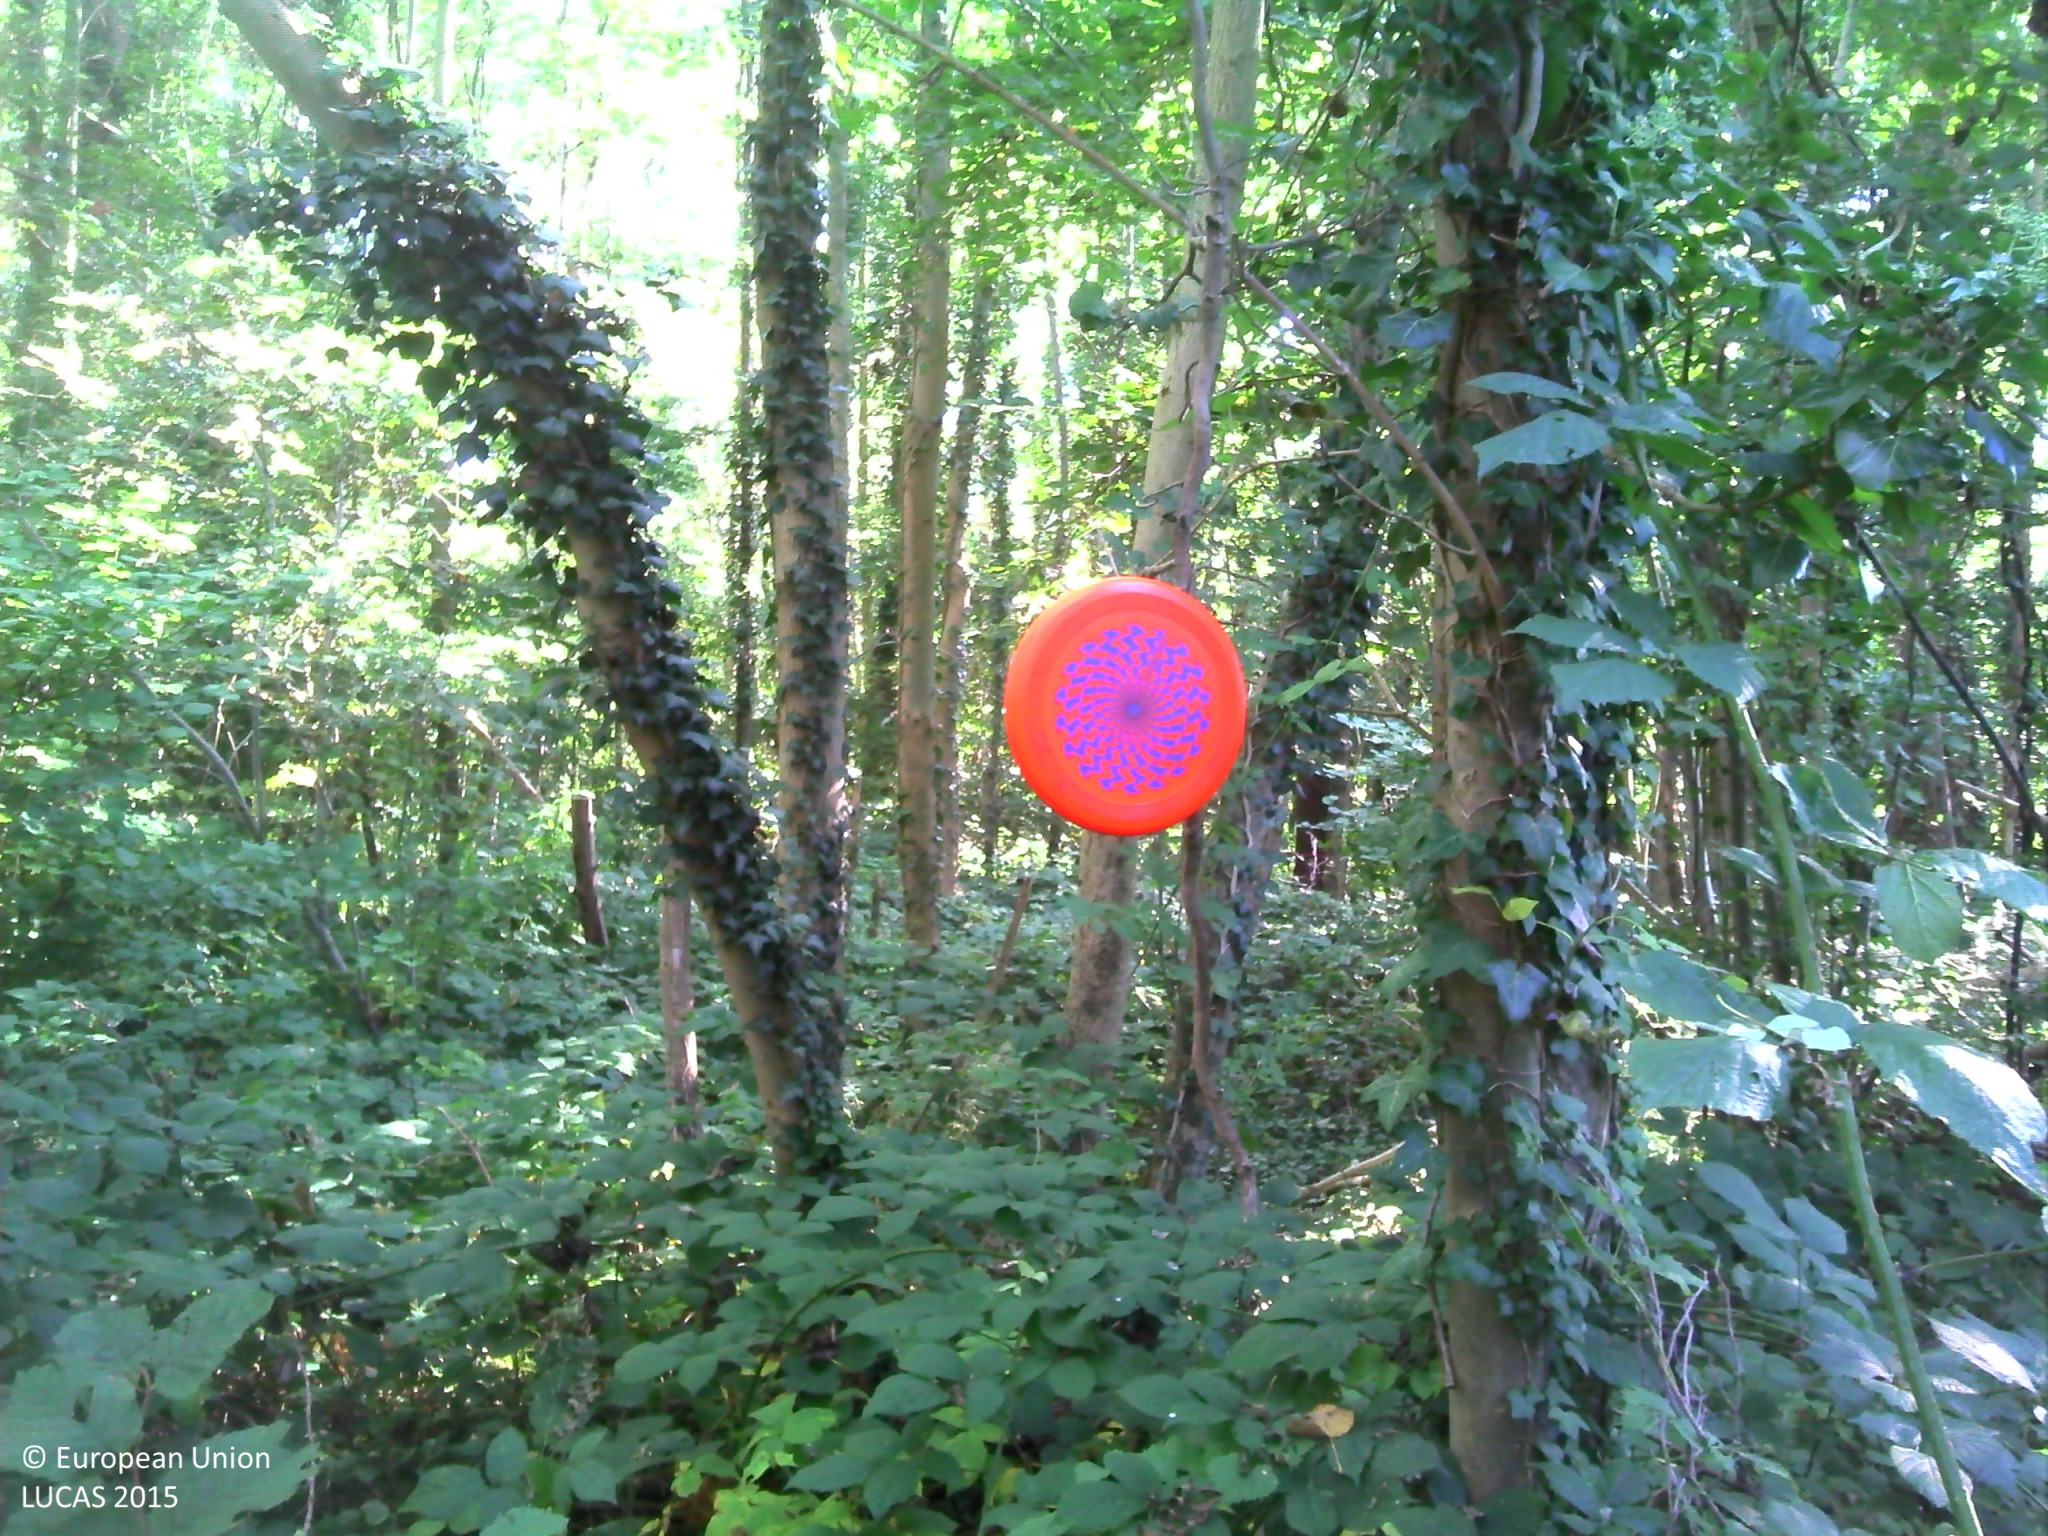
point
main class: Woodland
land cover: Broadleaved woodland
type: non-riverine alder, birch or aspen forest
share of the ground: > 75 %
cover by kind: broadleaved forest trees 95 %, herbaceous plants 5 %
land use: Forestry
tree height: > 5 m
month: September
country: BE
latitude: 51.2162
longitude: 4.7423
